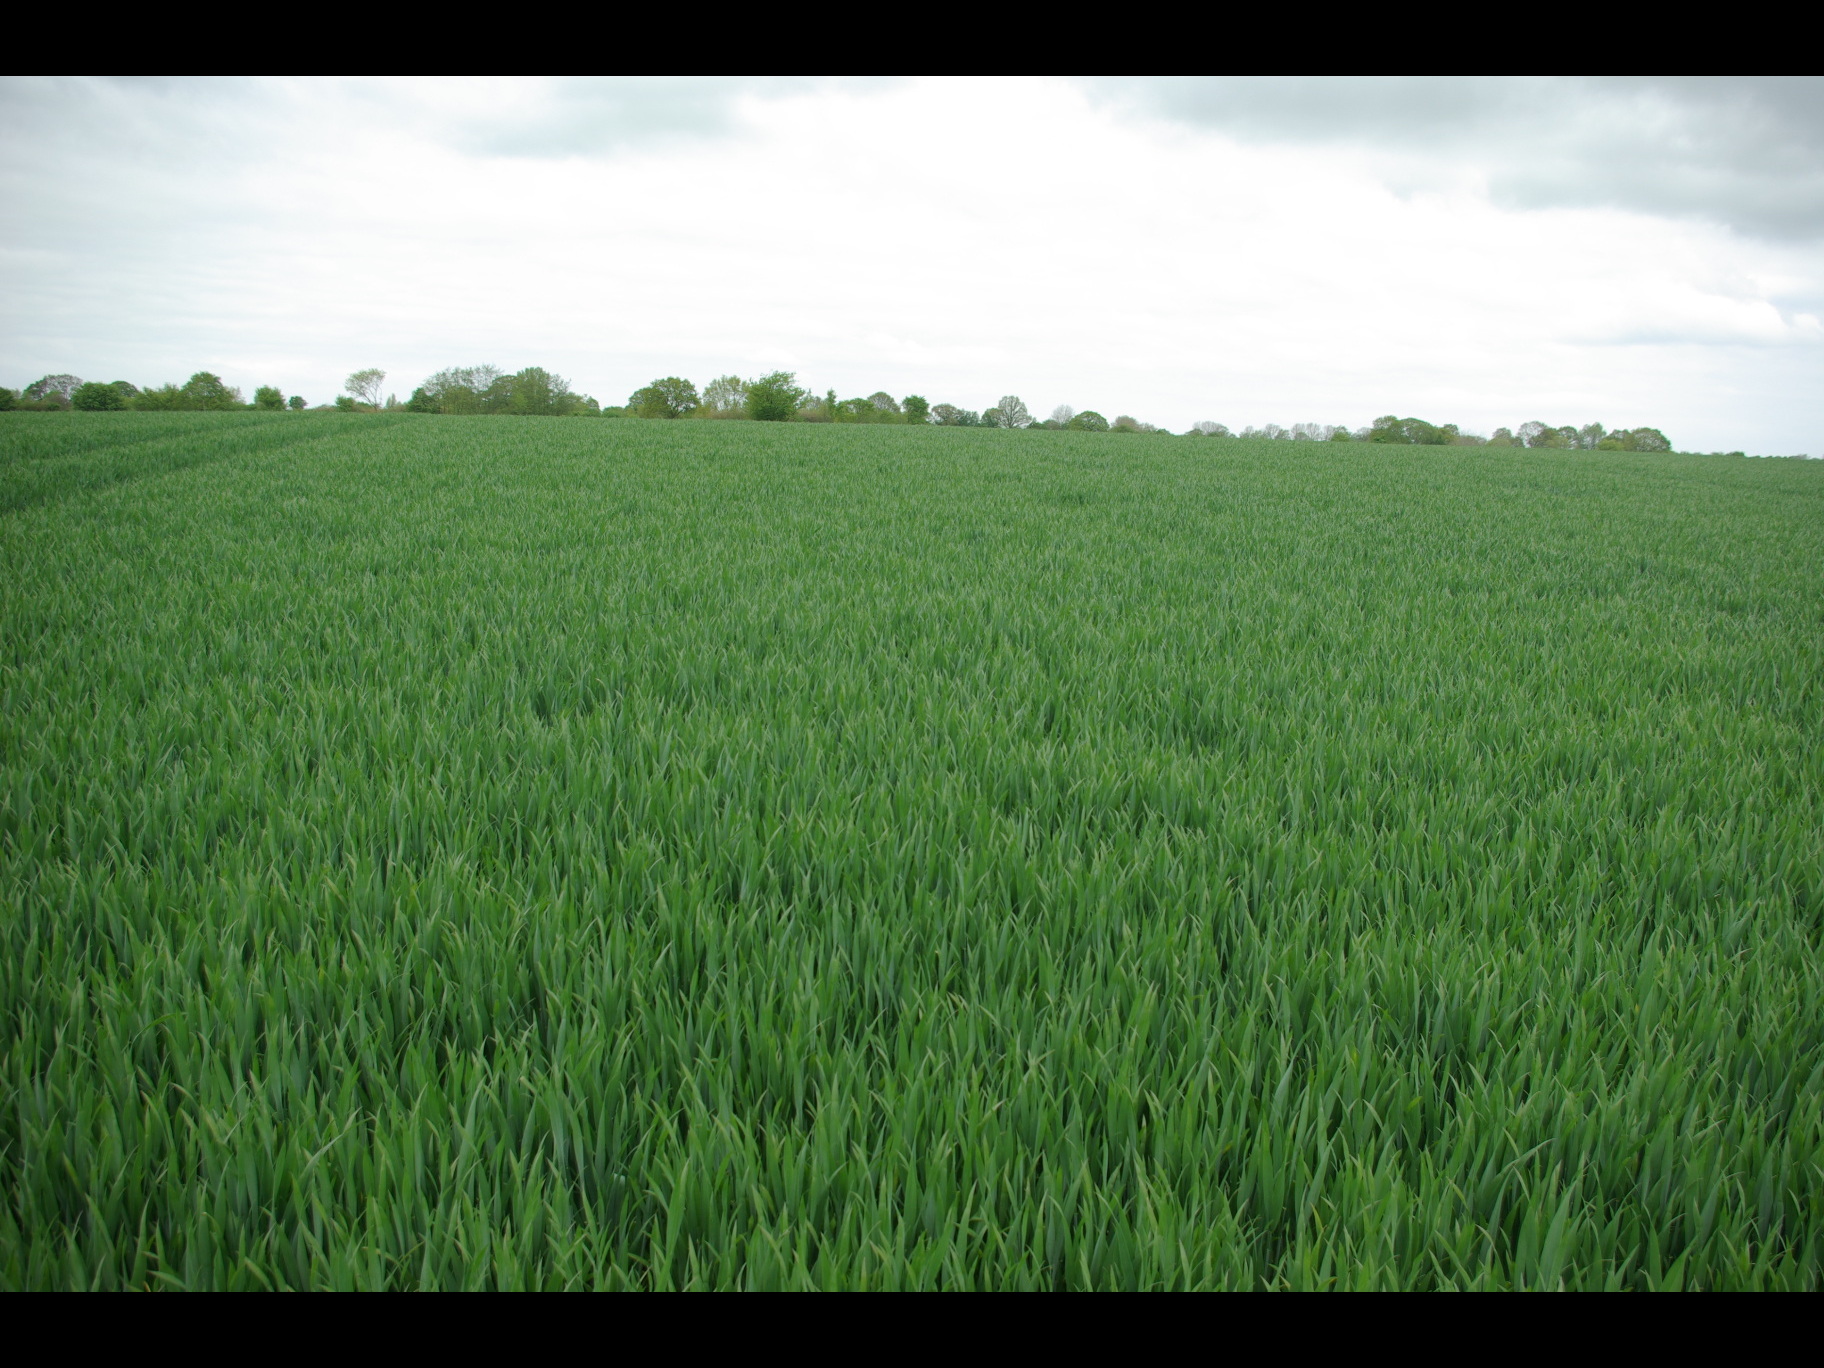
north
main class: Cropland
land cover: Common wheat
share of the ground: > 75 %
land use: Agriculture (excluding fallow land and kitchen gardens)
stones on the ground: < 10 %
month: May
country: DE
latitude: 54.2066
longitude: 10.9960
